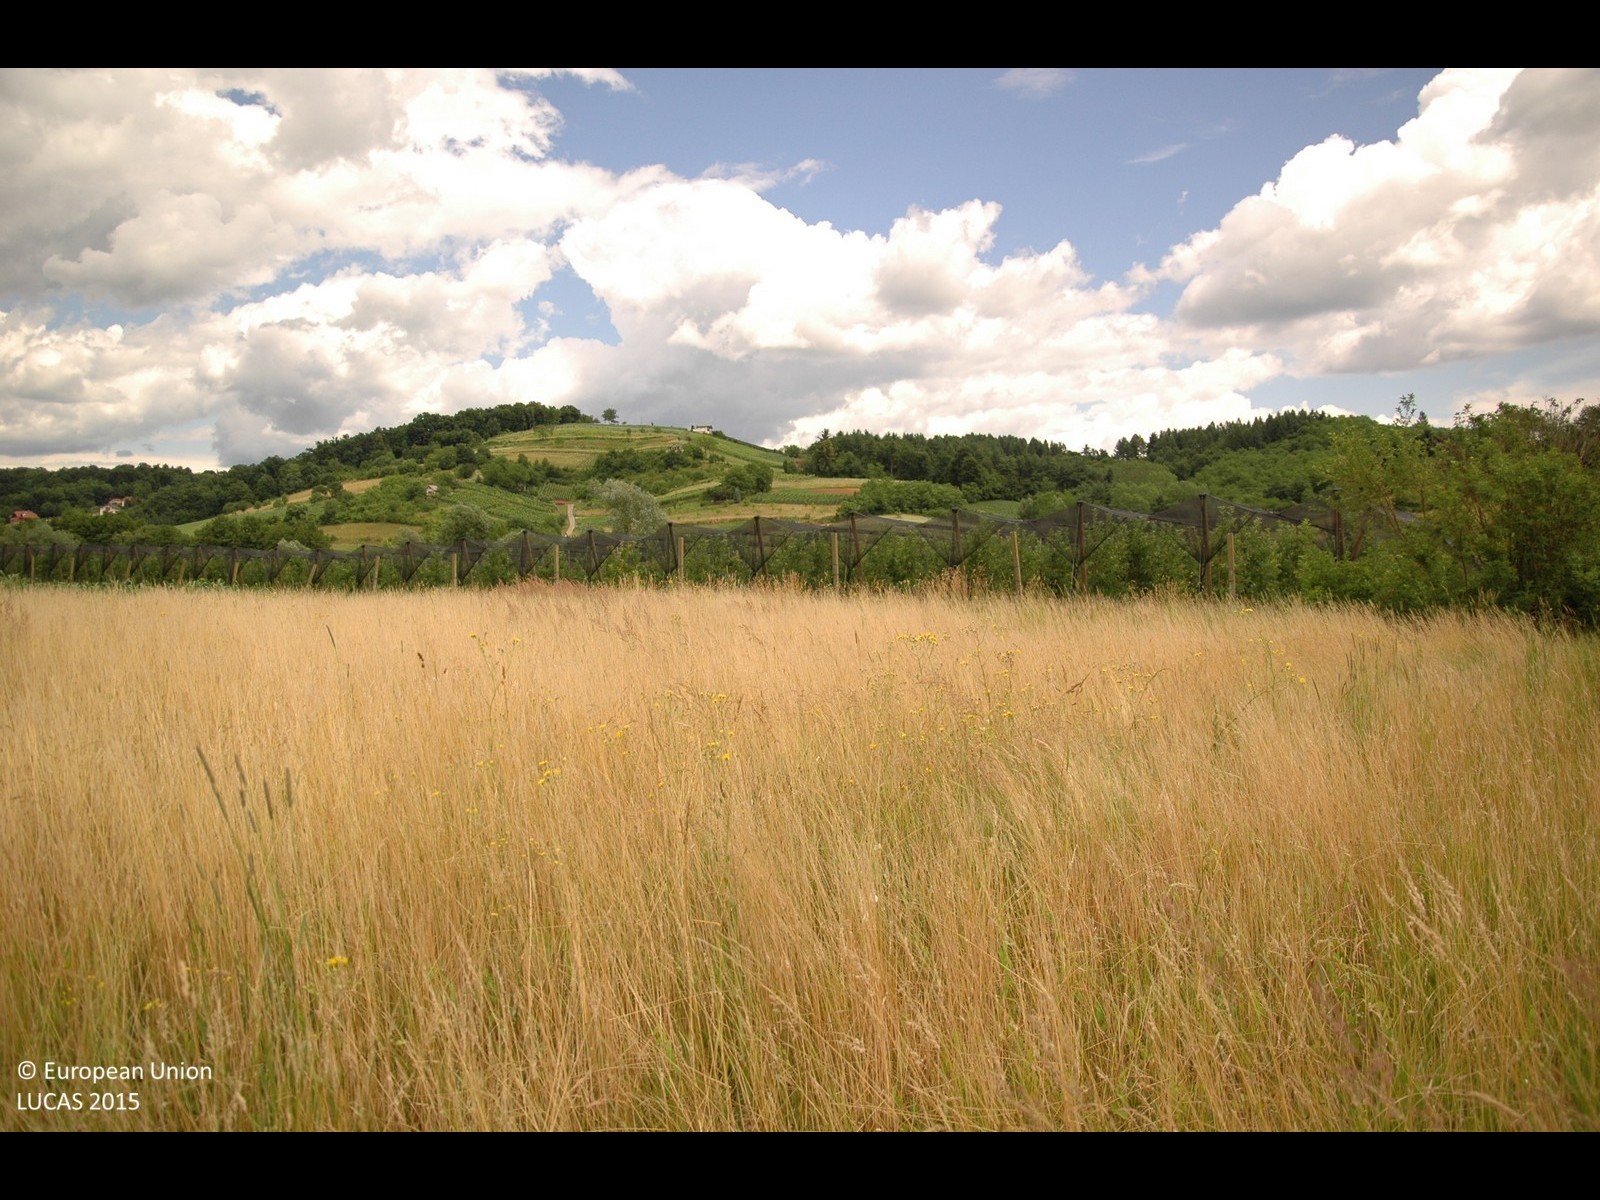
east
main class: Grassland
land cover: Grassland without tree/shrub cover
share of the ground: > 75 %
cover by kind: herbaceous plants 100 %
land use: Agriculture (excluding fallow land and kitchen gardens)
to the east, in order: Grassland without tree/shrub cover; Fences; Grass margins; Apple fruit; Grass margins; Fences; Abandoned hedges; Rivers and streams; Abandoned hedges; Grassland without tree/shrub cover
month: June
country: HR
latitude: 46.1348
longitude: 15.8880
